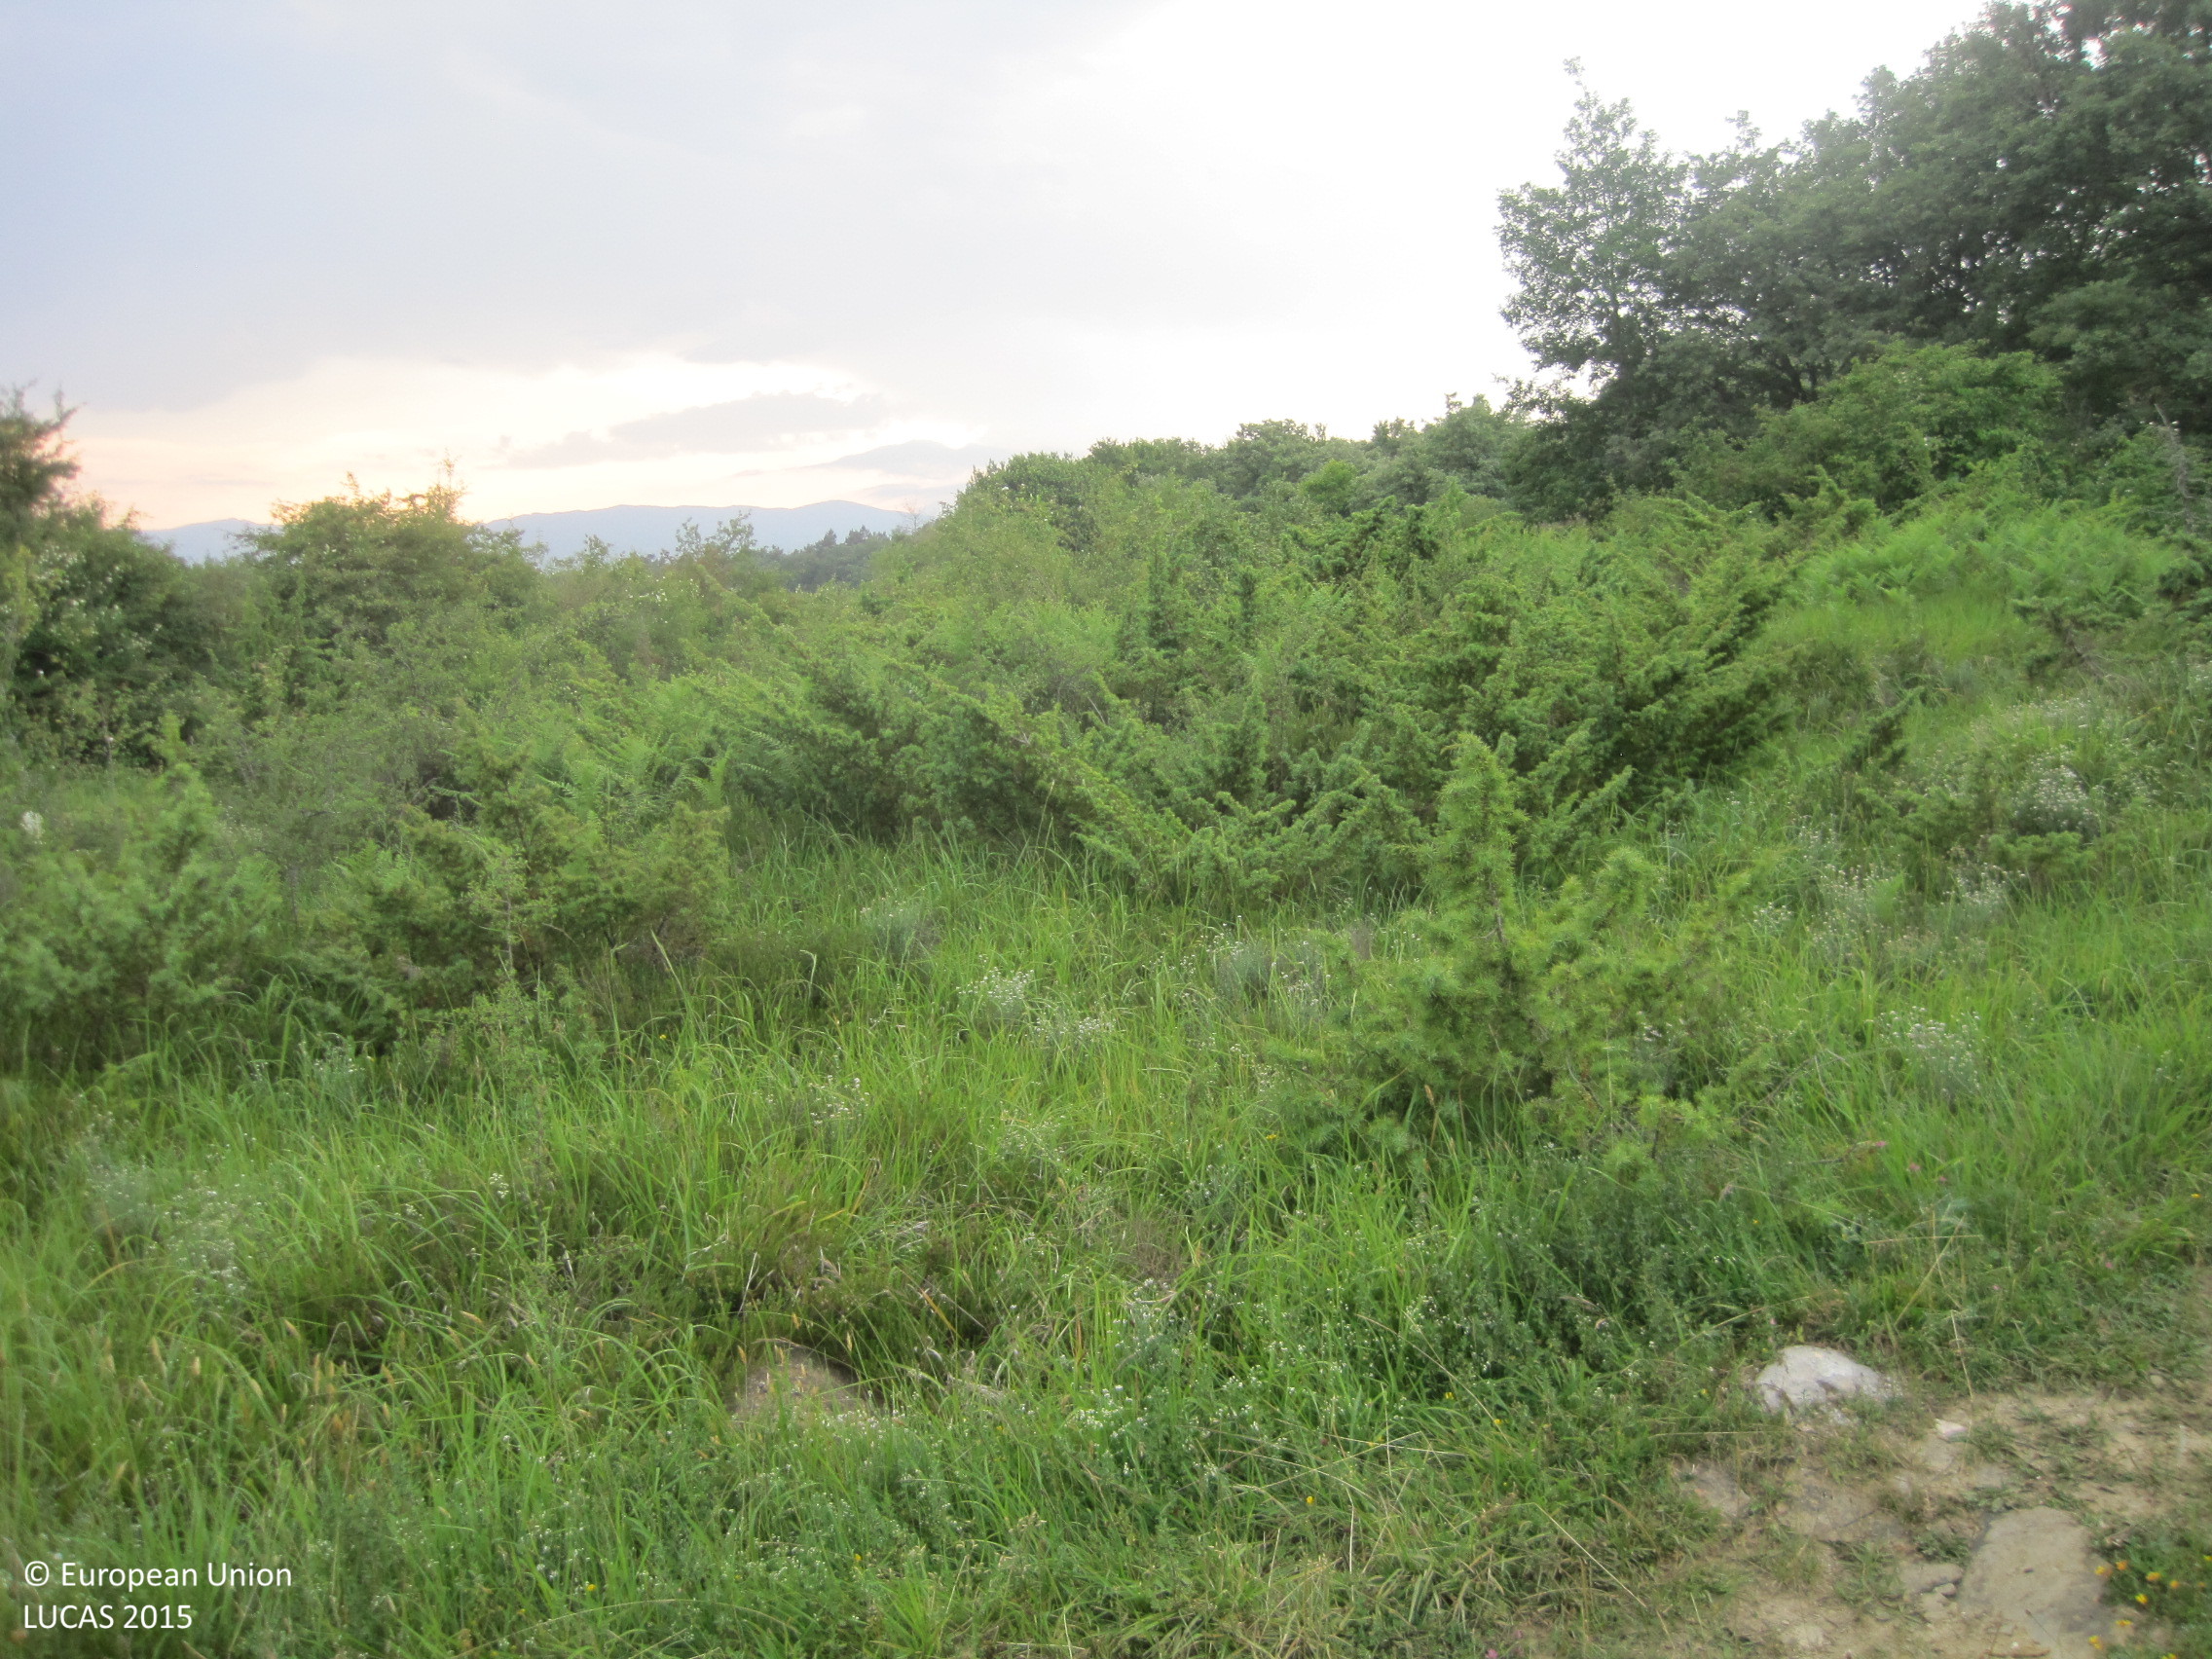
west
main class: Shrubland
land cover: Shrubland without tree cover
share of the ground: 10 - 25 %
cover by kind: herbaceous plants 80 %, shrubs 20 %
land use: Semi-natural and natural areas not in use
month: June
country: ES
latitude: 42.9728
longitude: -1.7264
